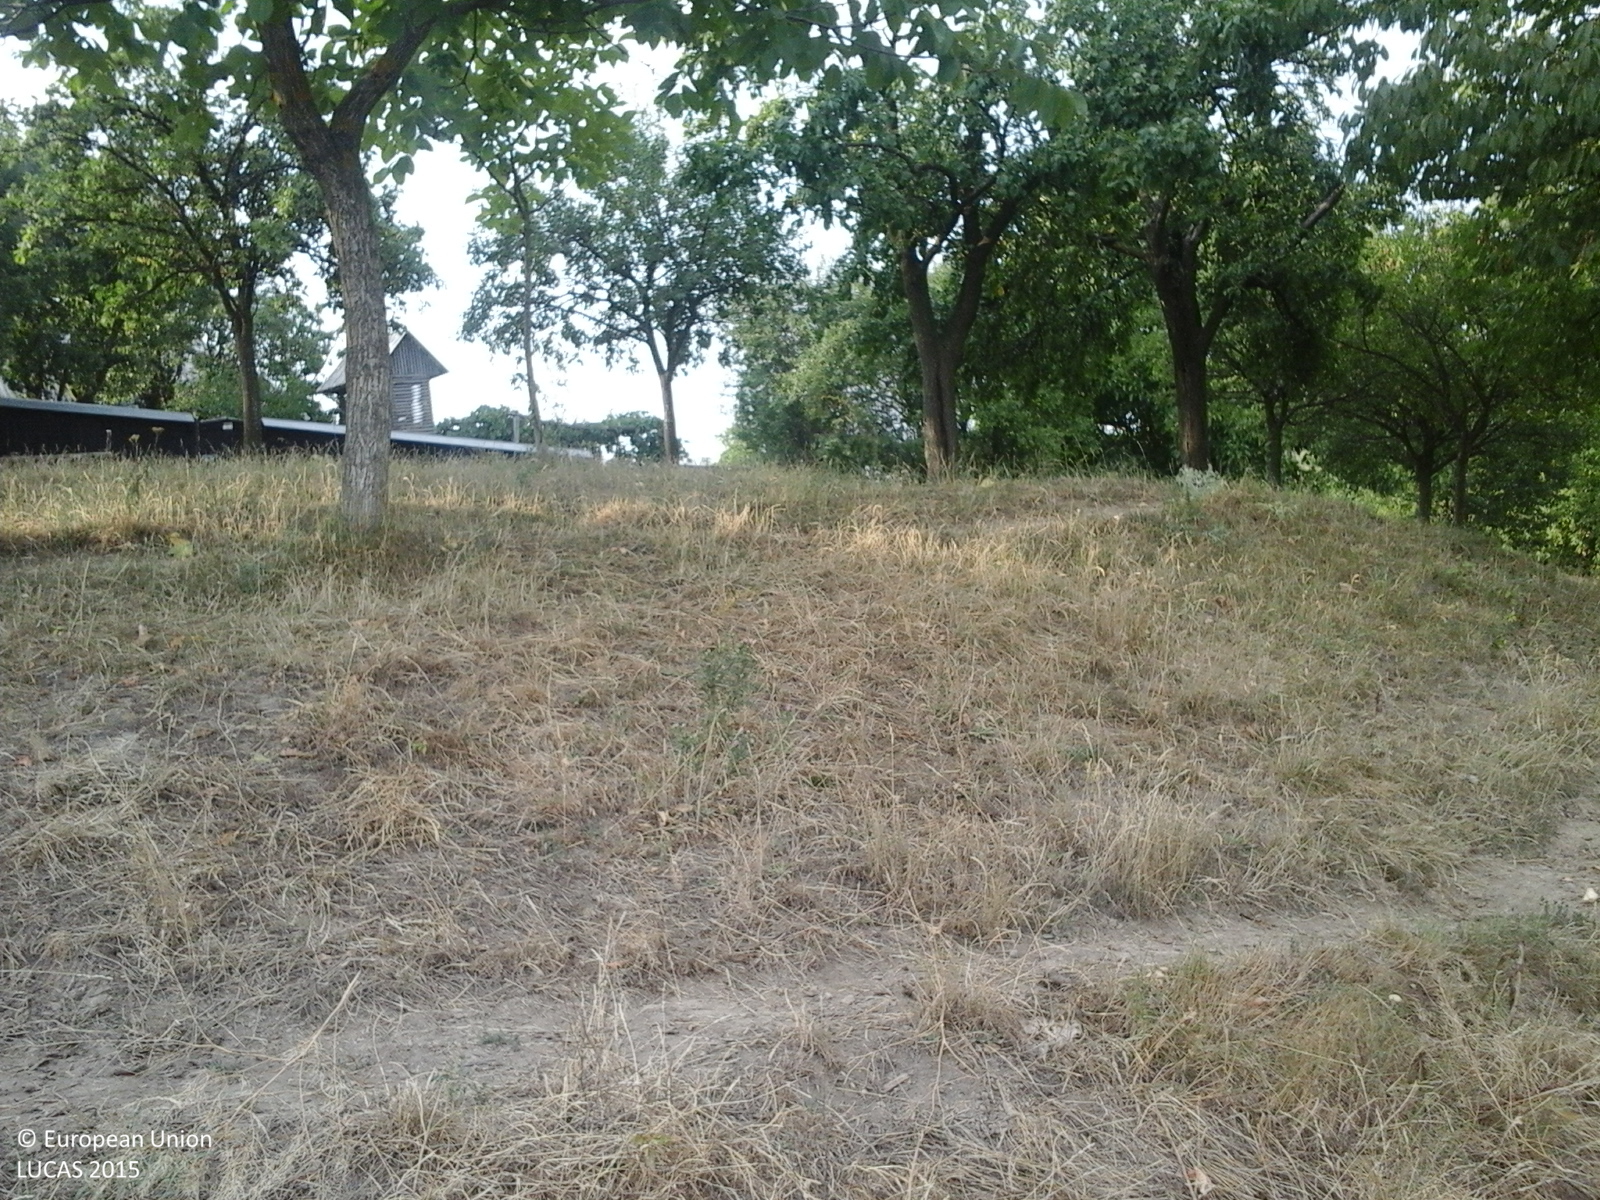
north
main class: Grassland
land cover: Grassland with sparse tree/shrub cover
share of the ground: > 75 %
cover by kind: herbaceous plants 90 %, broadleaved forest trees 5 %, shrubs 5 %
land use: Agriculture (excluding fallow land and kitchen gardens)
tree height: > 5 m
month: July
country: RO
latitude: 46.1885
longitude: 26.7885
